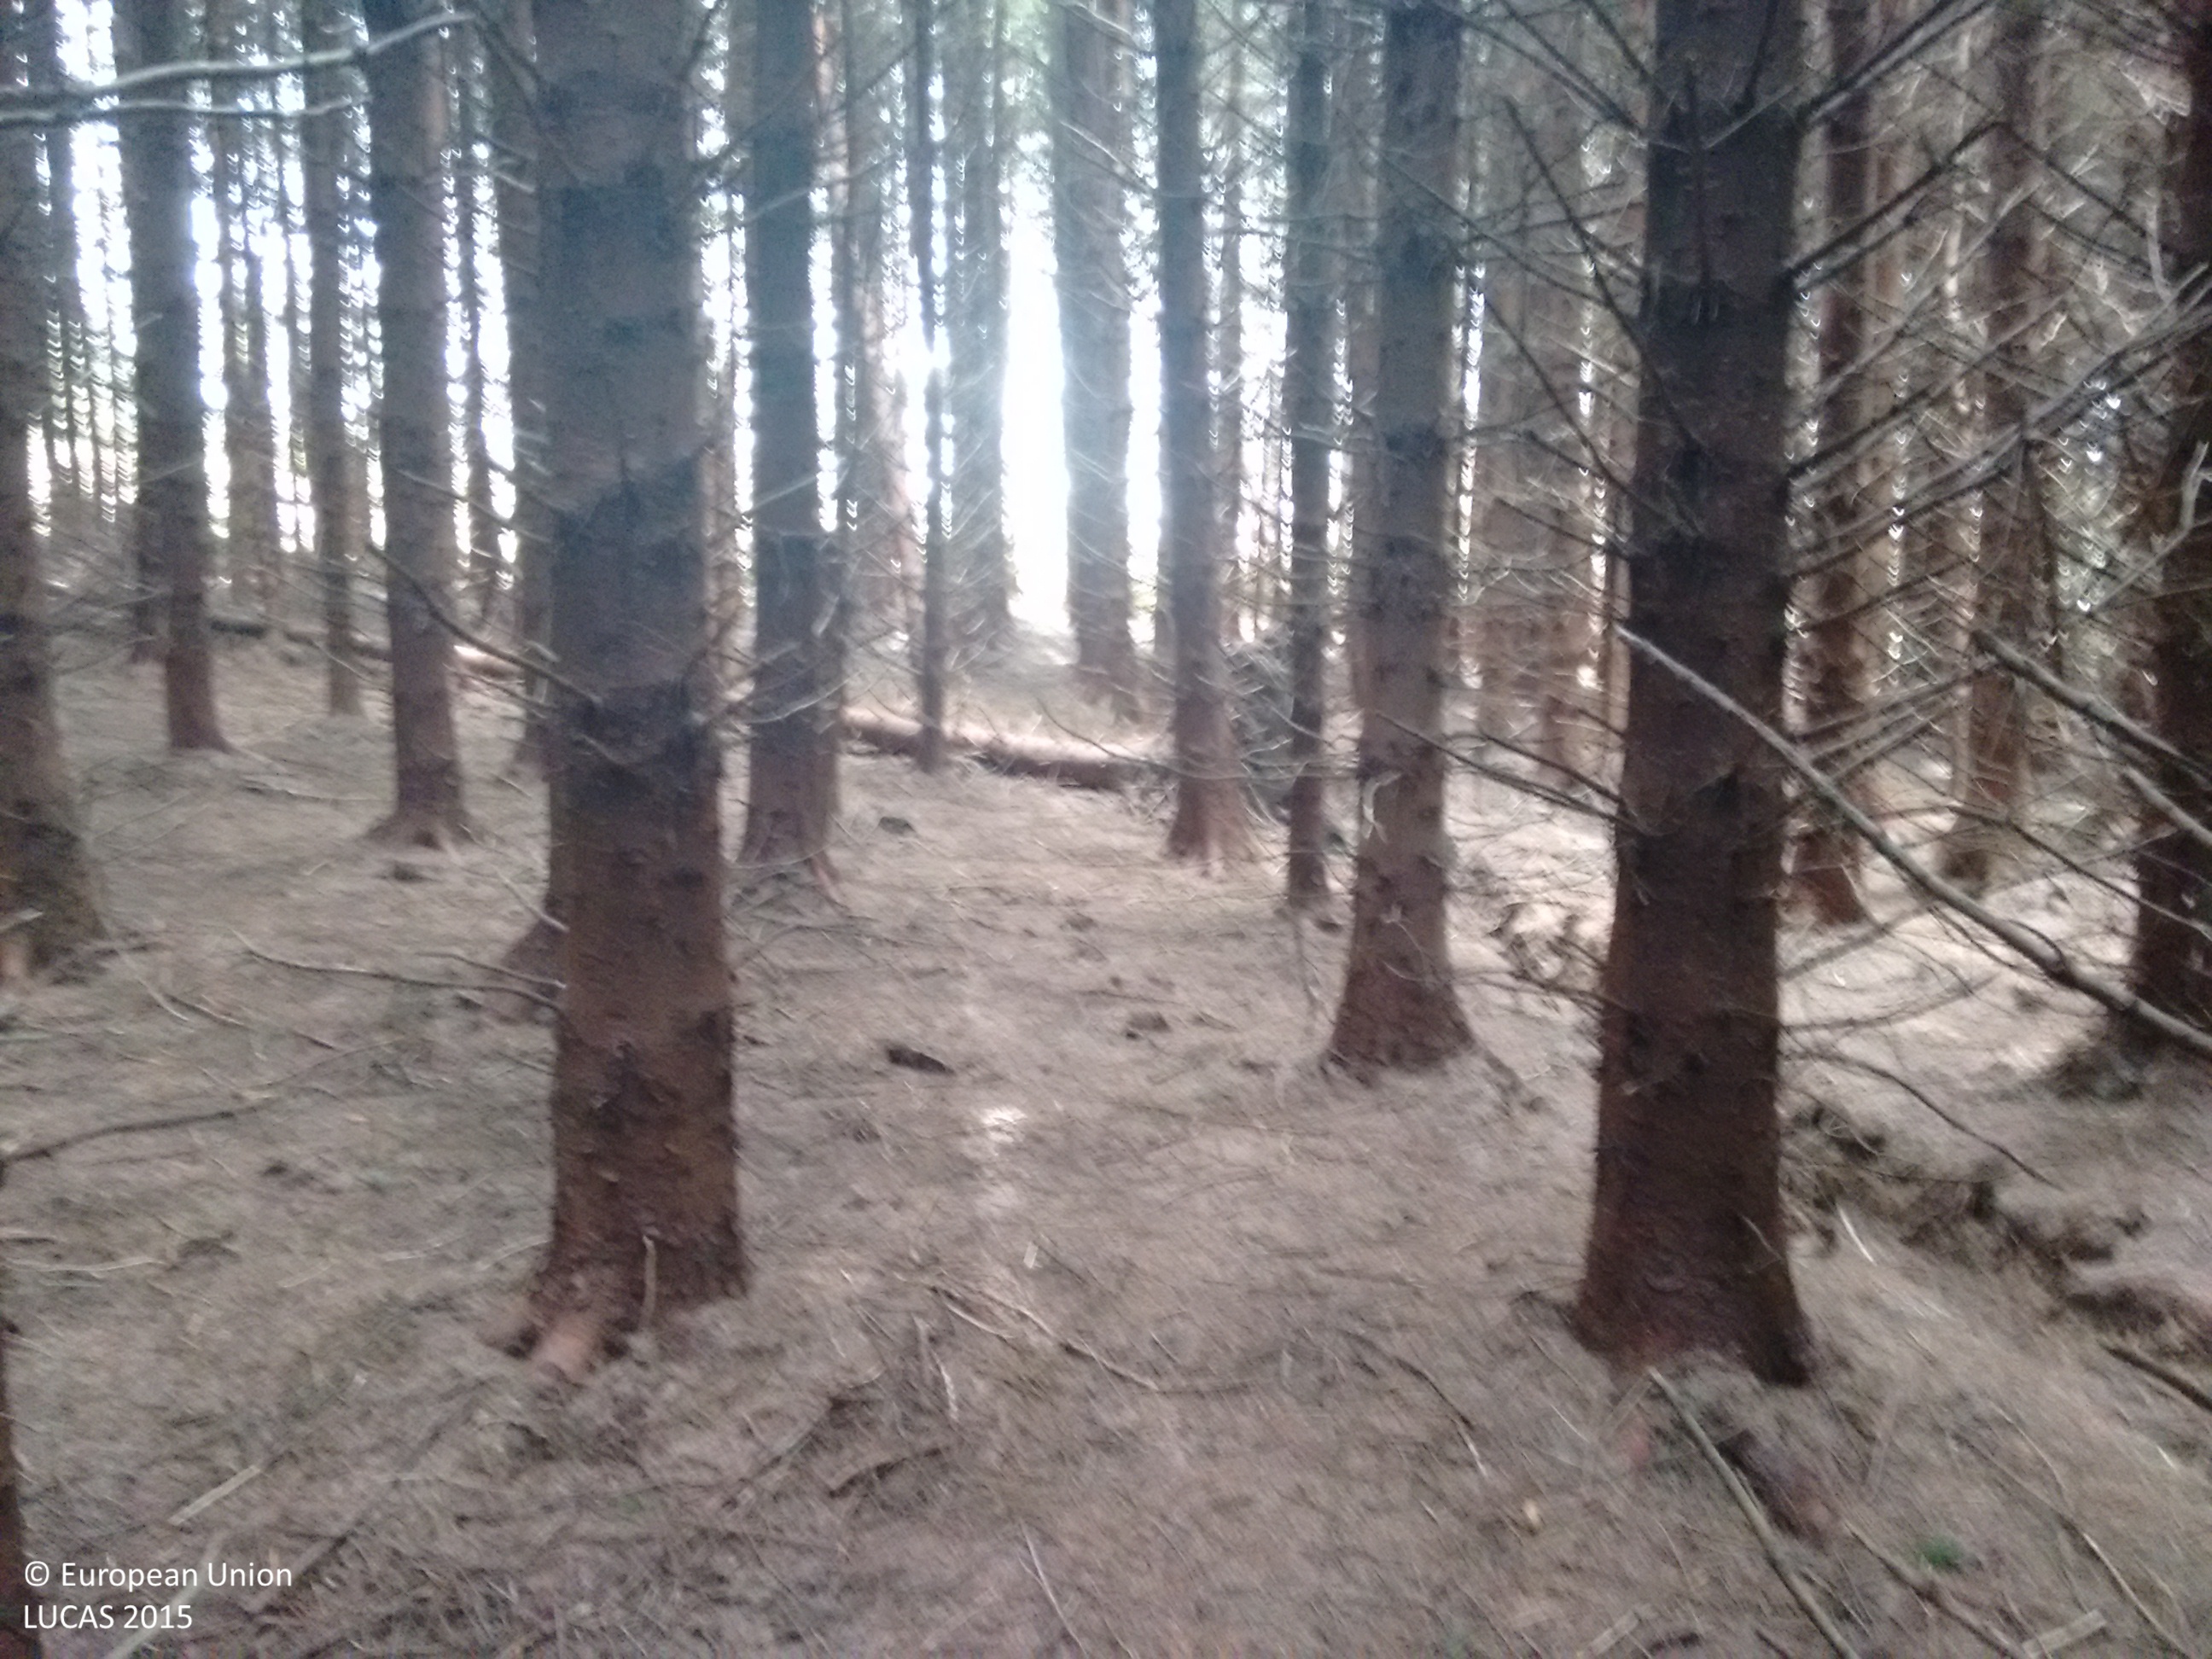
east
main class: Woodland
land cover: Spruce dominated coniferous woodland
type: exotic forest
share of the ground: > 75 %
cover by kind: coniferous forest trees 100 %
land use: Forestry
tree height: > 5 m
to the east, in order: Spruce dominated coniferous woodland; Fences; Grassland without tree/shrub cover; Abandoned hedges; Peatbogs
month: September
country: IE
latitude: 52.2065
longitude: -9.3529
